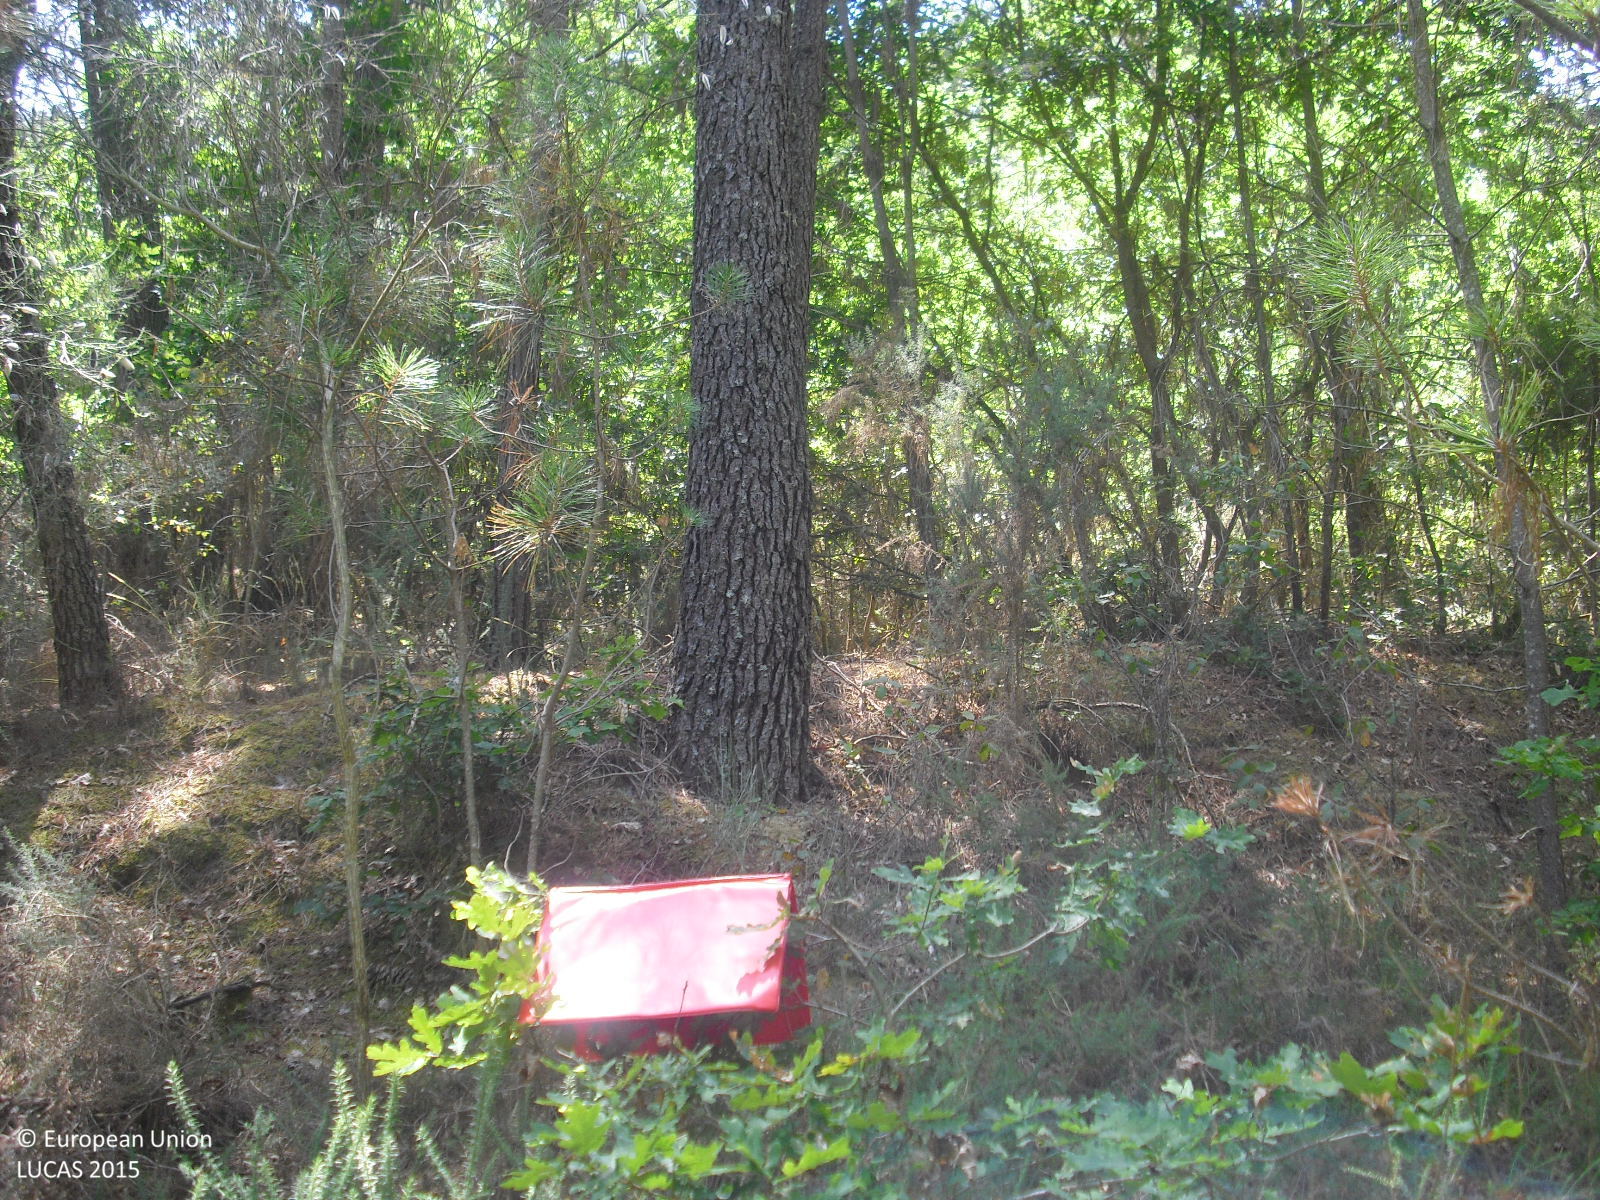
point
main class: Woodland
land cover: Pine dominated mixed woodland
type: hemiboreal forest and nemoral coniferous forest and mixed broadleaved-coniferous forest
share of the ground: 50 - 75 %
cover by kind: coniferous forest trees 45 %, broadleaved forest trees 35 %, shrubs 20 %
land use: Forestry
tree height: > 5 m
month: July
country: ES
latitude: 42.5063
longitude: -7.4587
